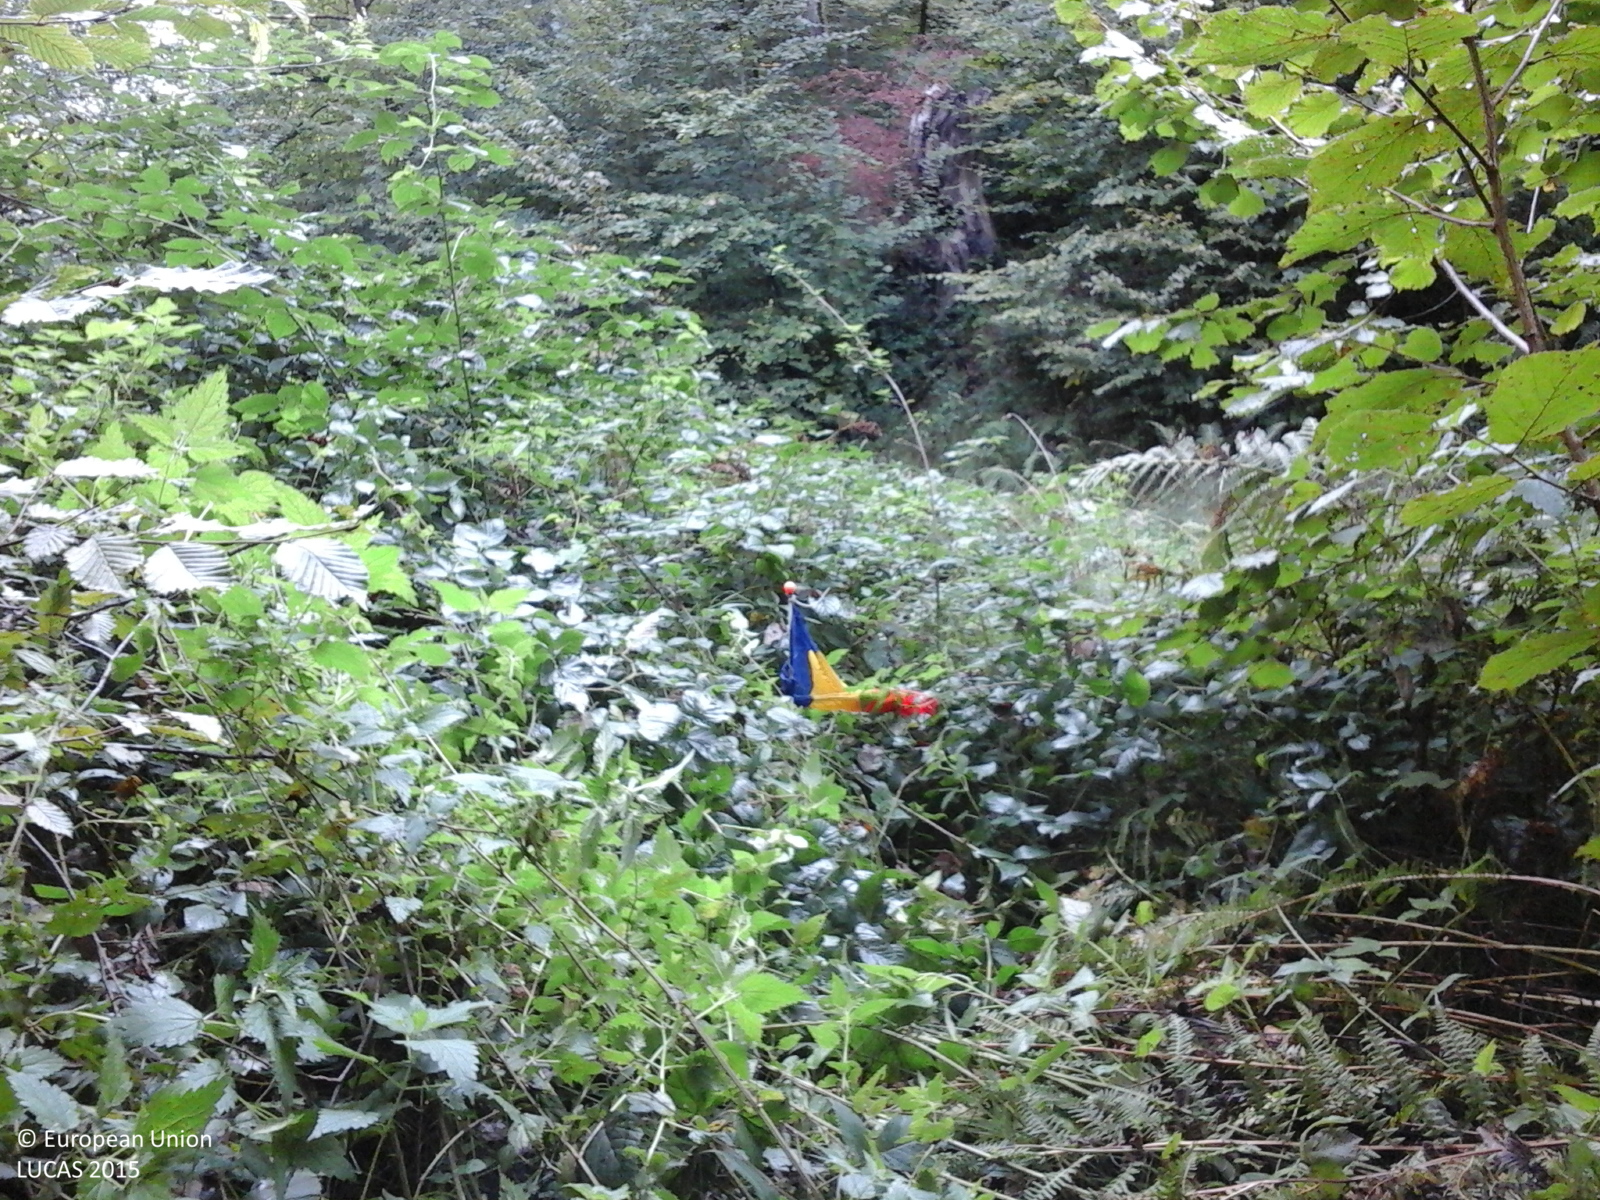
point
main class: Woodland
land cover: Broadleaved woodland
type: beech forest
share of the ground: > 75 %
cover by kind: broadleaved forest trees 100 %
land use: Forestry
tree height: > 5 m
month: September
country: RO
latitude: 45.5906
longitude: 22.7005
